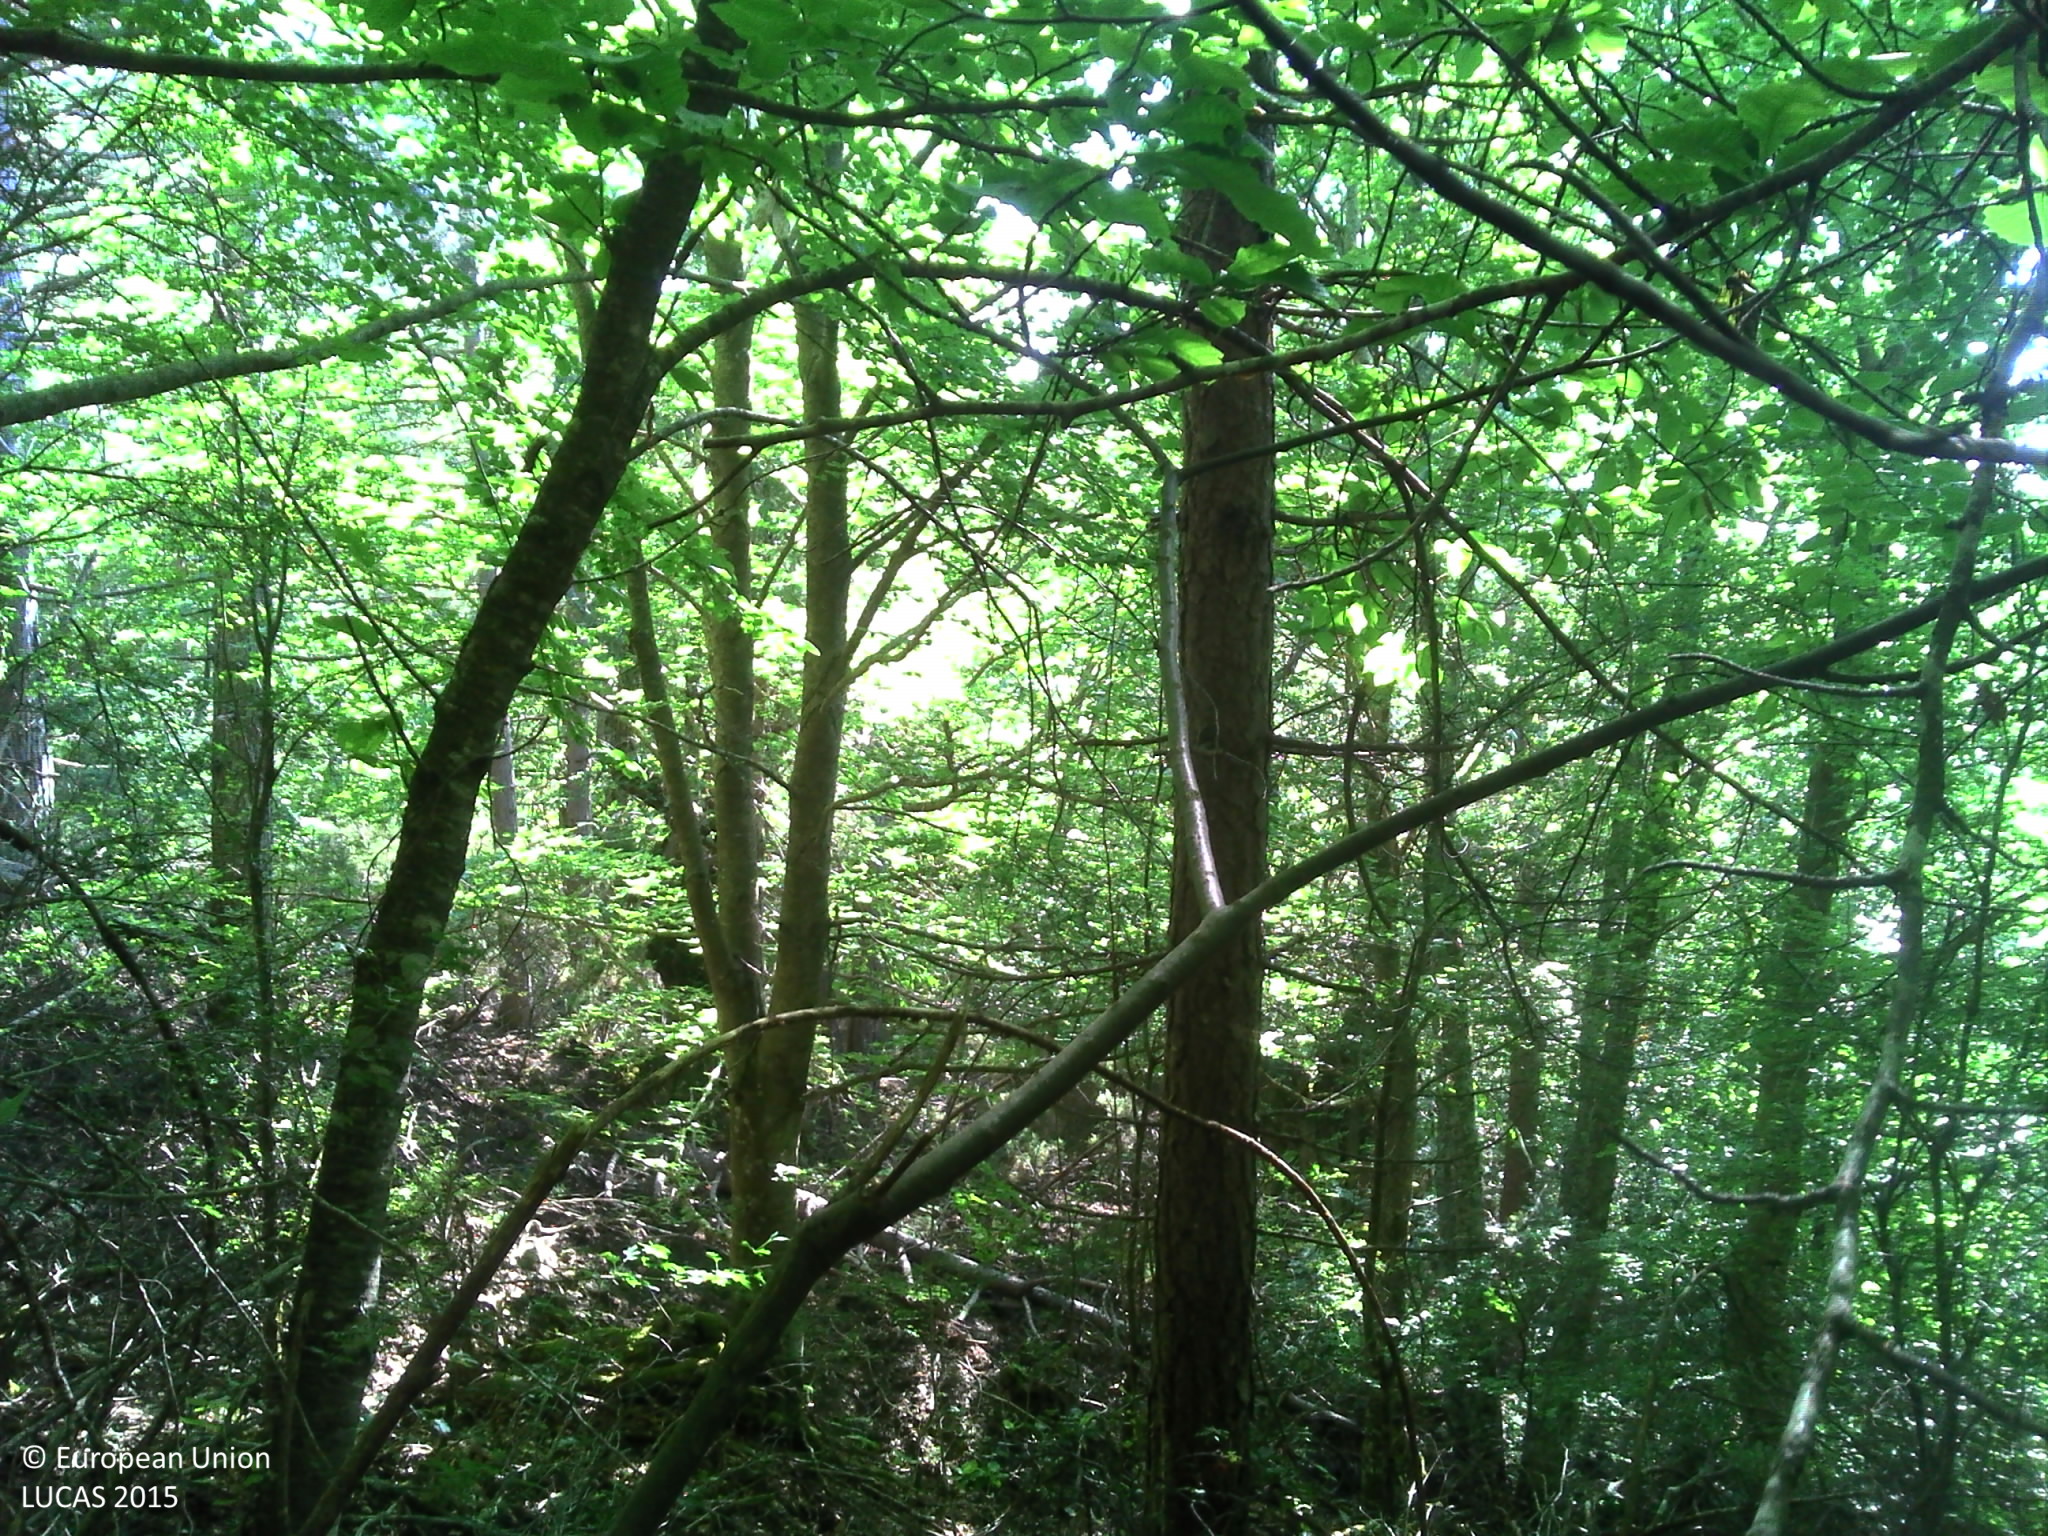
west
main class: Woodland
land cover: Broadleaved woodland
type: mountainous beech forest
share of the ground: > 75 %
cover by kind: broadleaved forest trees 100 %
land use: Forestry
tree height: > 5 m
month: June
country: FR
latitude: 42.2904
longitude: 9.3112
